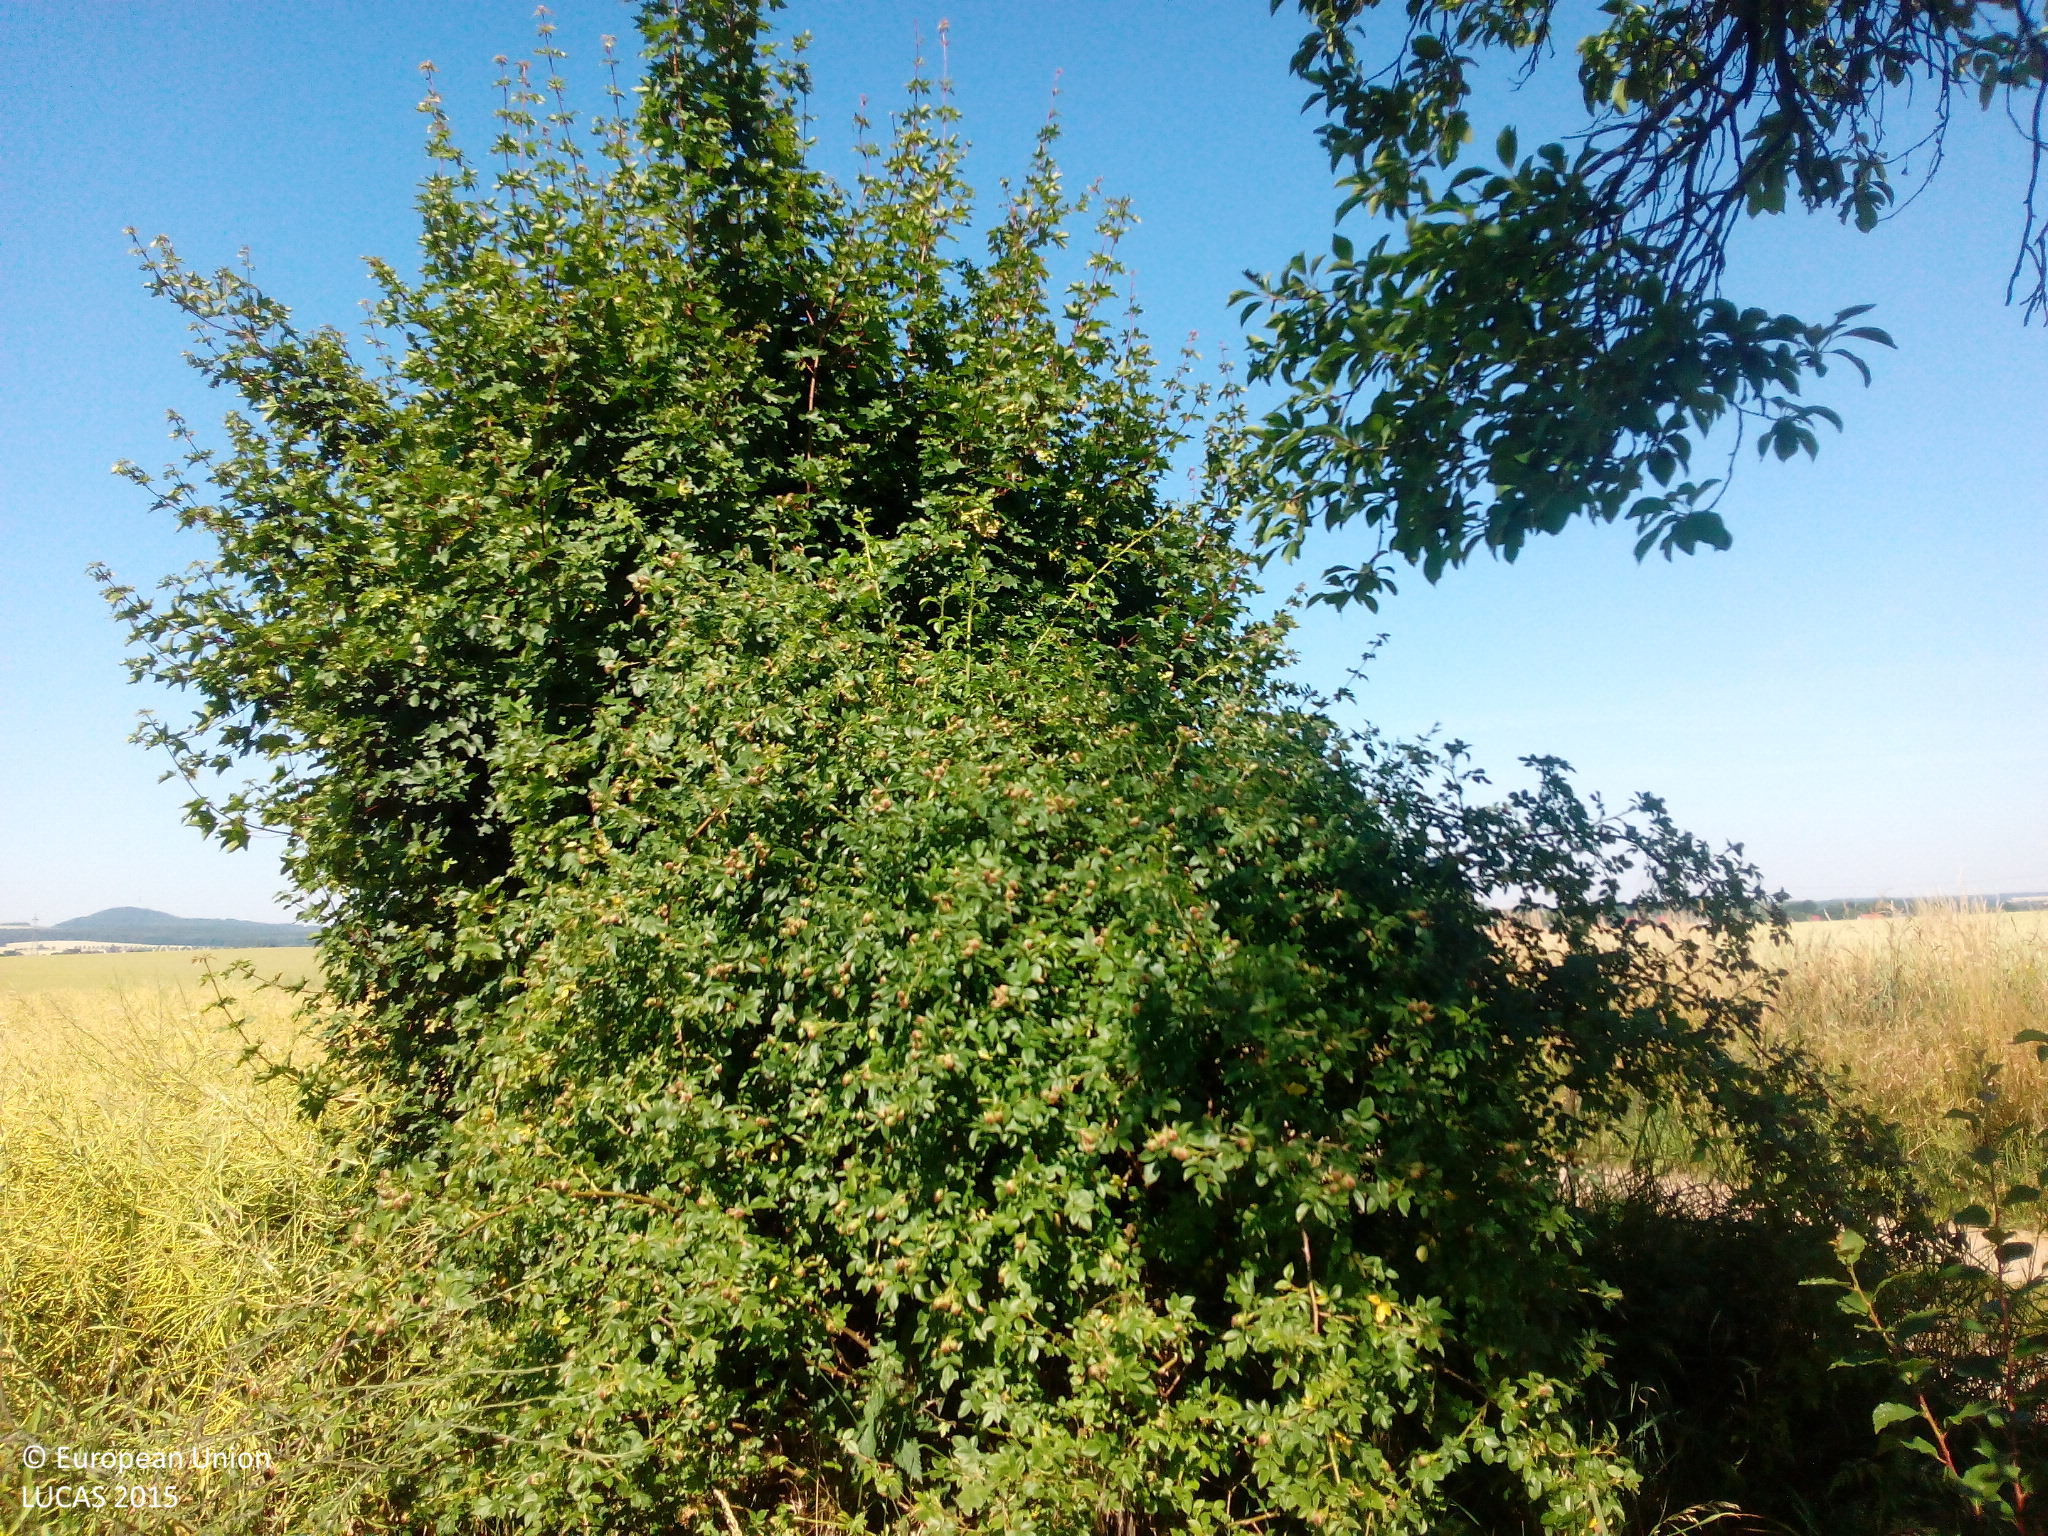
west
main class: Cropland
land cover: Rape and turnip rape
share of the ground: > 75 %
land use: Agriculture (excluding fallow land and kitchen gardens)
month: July
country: DE
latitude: 51.3293
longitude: 13.1144
